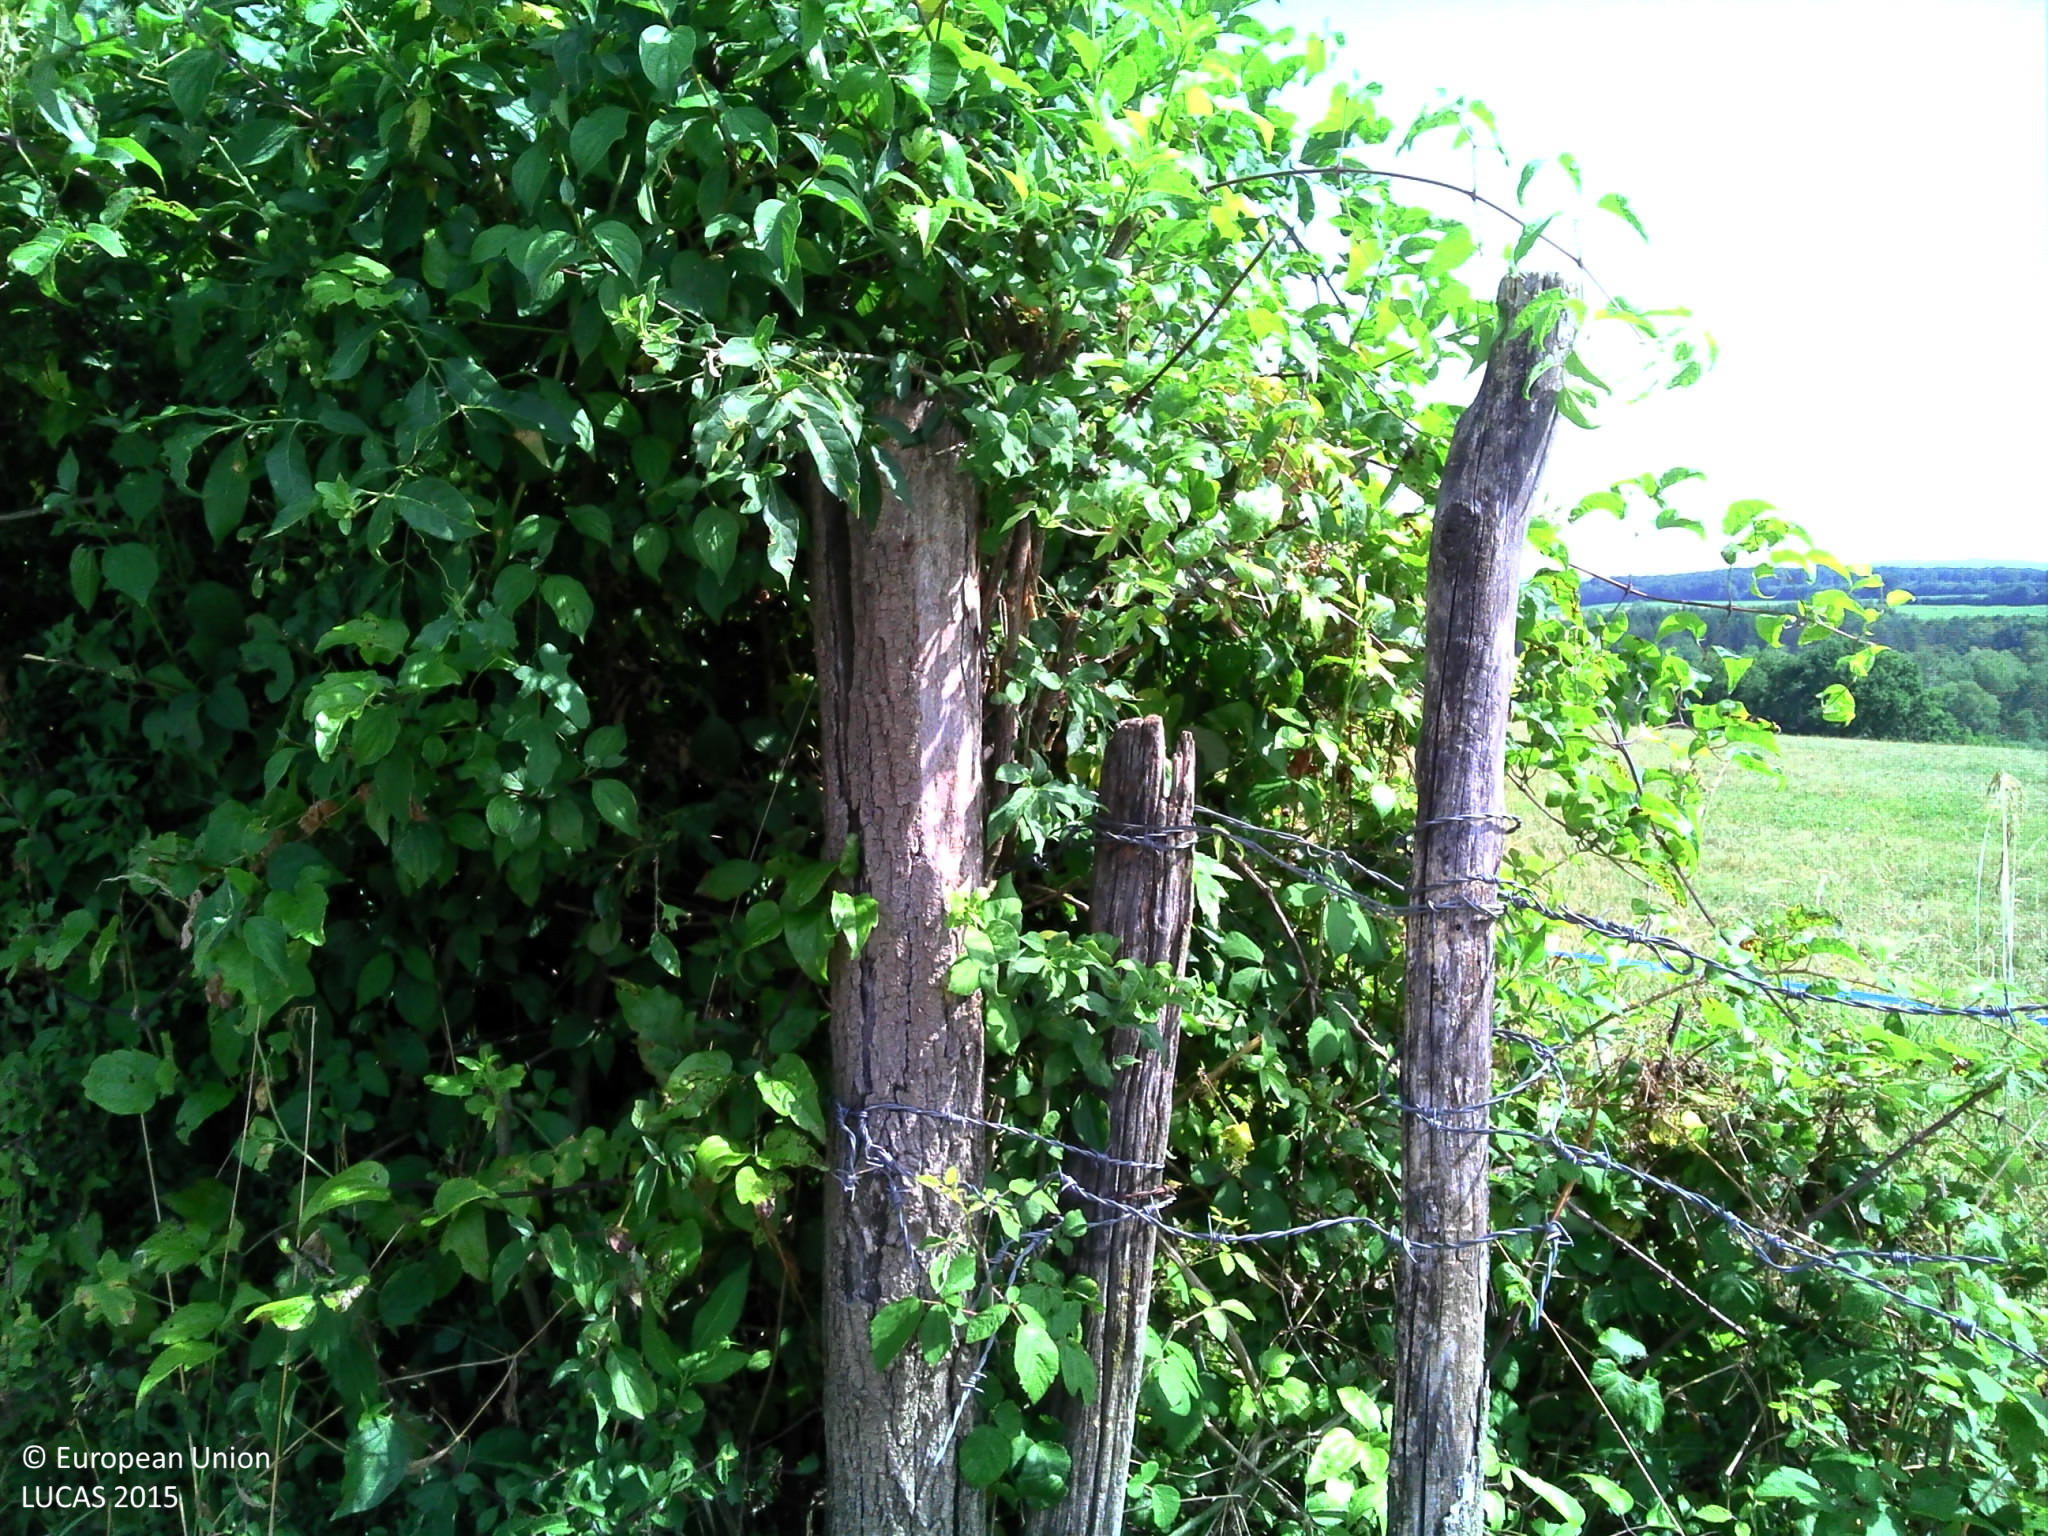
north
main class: Grassland
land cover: Grassland without tree/shrub cover
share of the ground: > 75 %
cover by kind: herbaceous plants 100 %
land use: Agriculture (excluding fallow land and kitchen gardens)
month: July
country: FR
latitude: 45.7275
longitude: 5.3654
